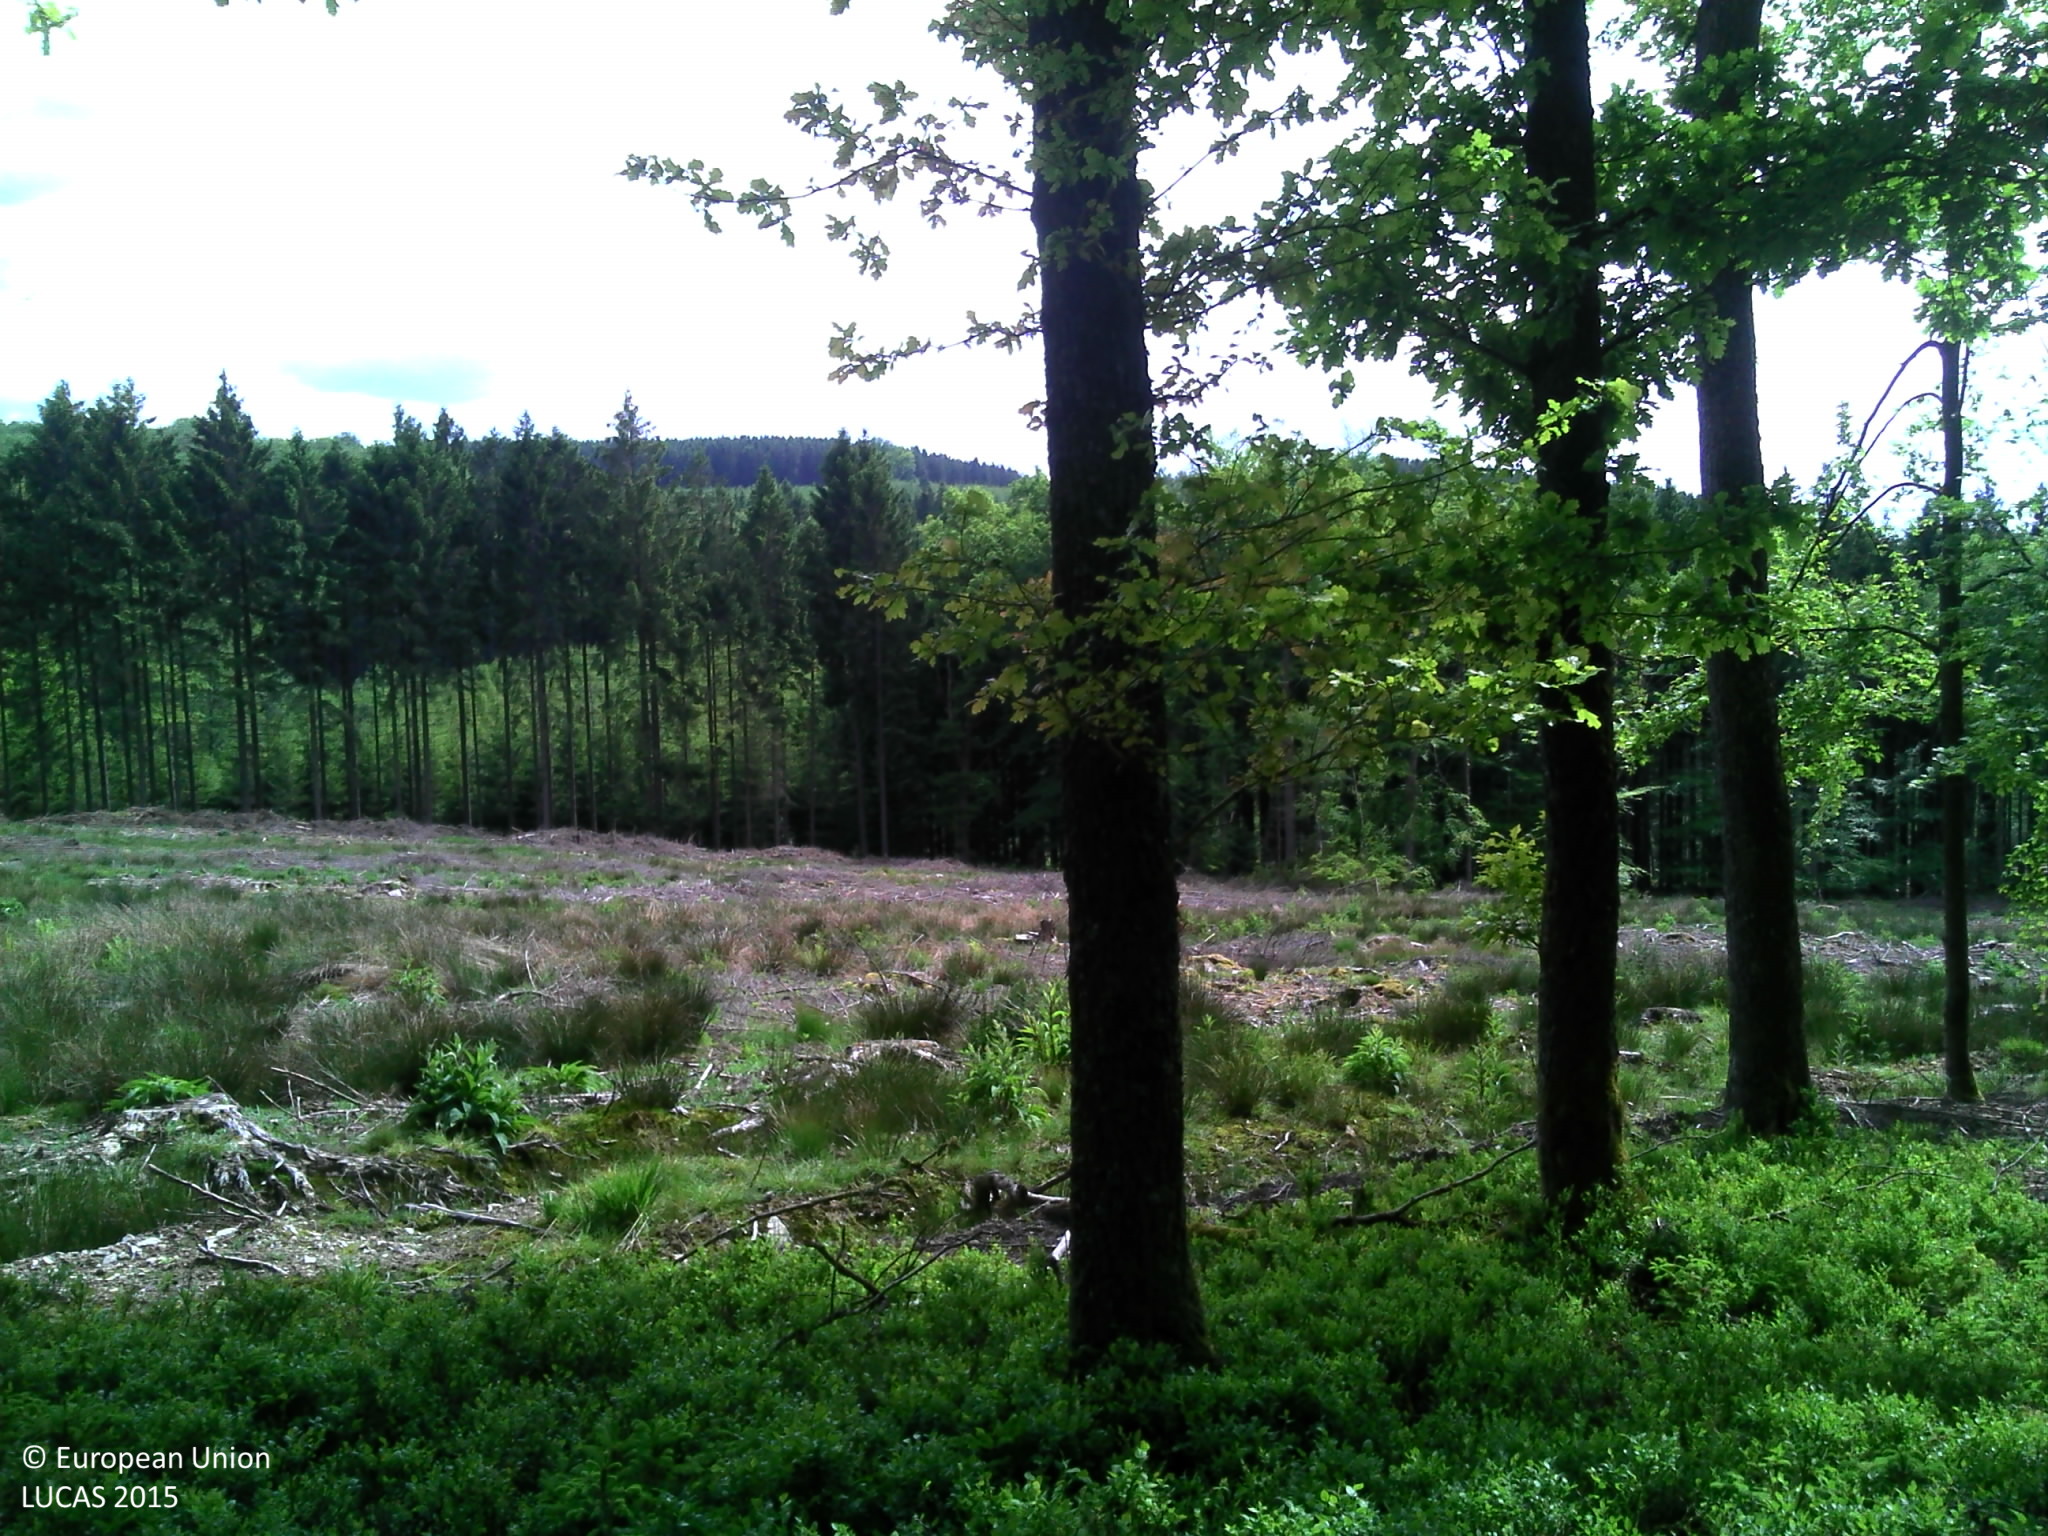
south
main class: Shrubland
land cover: Shrubland without tree cover
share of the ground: > 75 %
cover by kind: herbaceous plants 45 %, shrubs 25 %, unconsolidated bare surface 15 %
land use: Forestry
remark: Clear cut
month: June
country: BE
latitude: 50.3578
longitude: 5.7678
